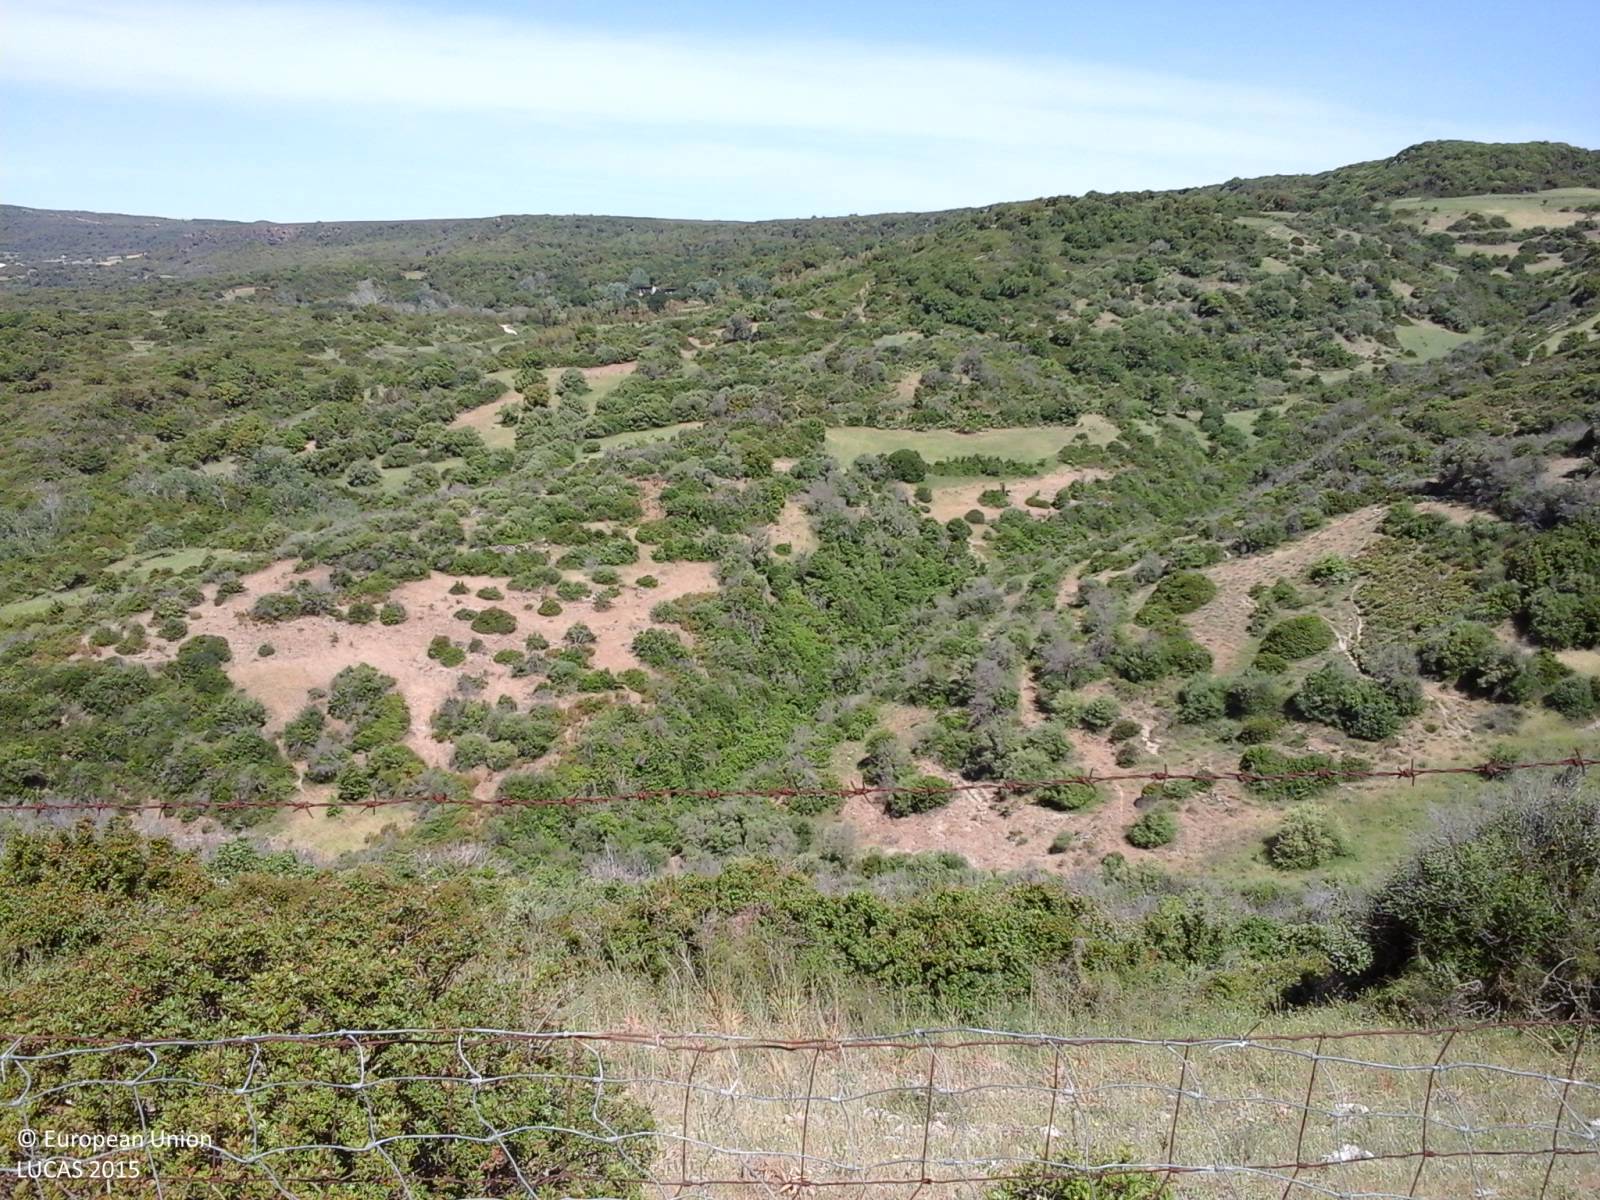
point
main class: Woodland
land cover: Broadleaved woodland
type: broadleaved evergreen forest
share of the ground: 50 - 75 %
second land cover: Grassland without tree/shrub cover
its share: 50 - 75 %
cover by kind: broadleaved forest trees 70 %, herbaceous plants 20 %, shrubs 10 %
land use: Forestry
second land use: Agriculture (excluding fallow land and kitchen gardens)
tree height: < 5 m
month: May
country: IT
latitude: 39.8076
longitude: 8.8269
